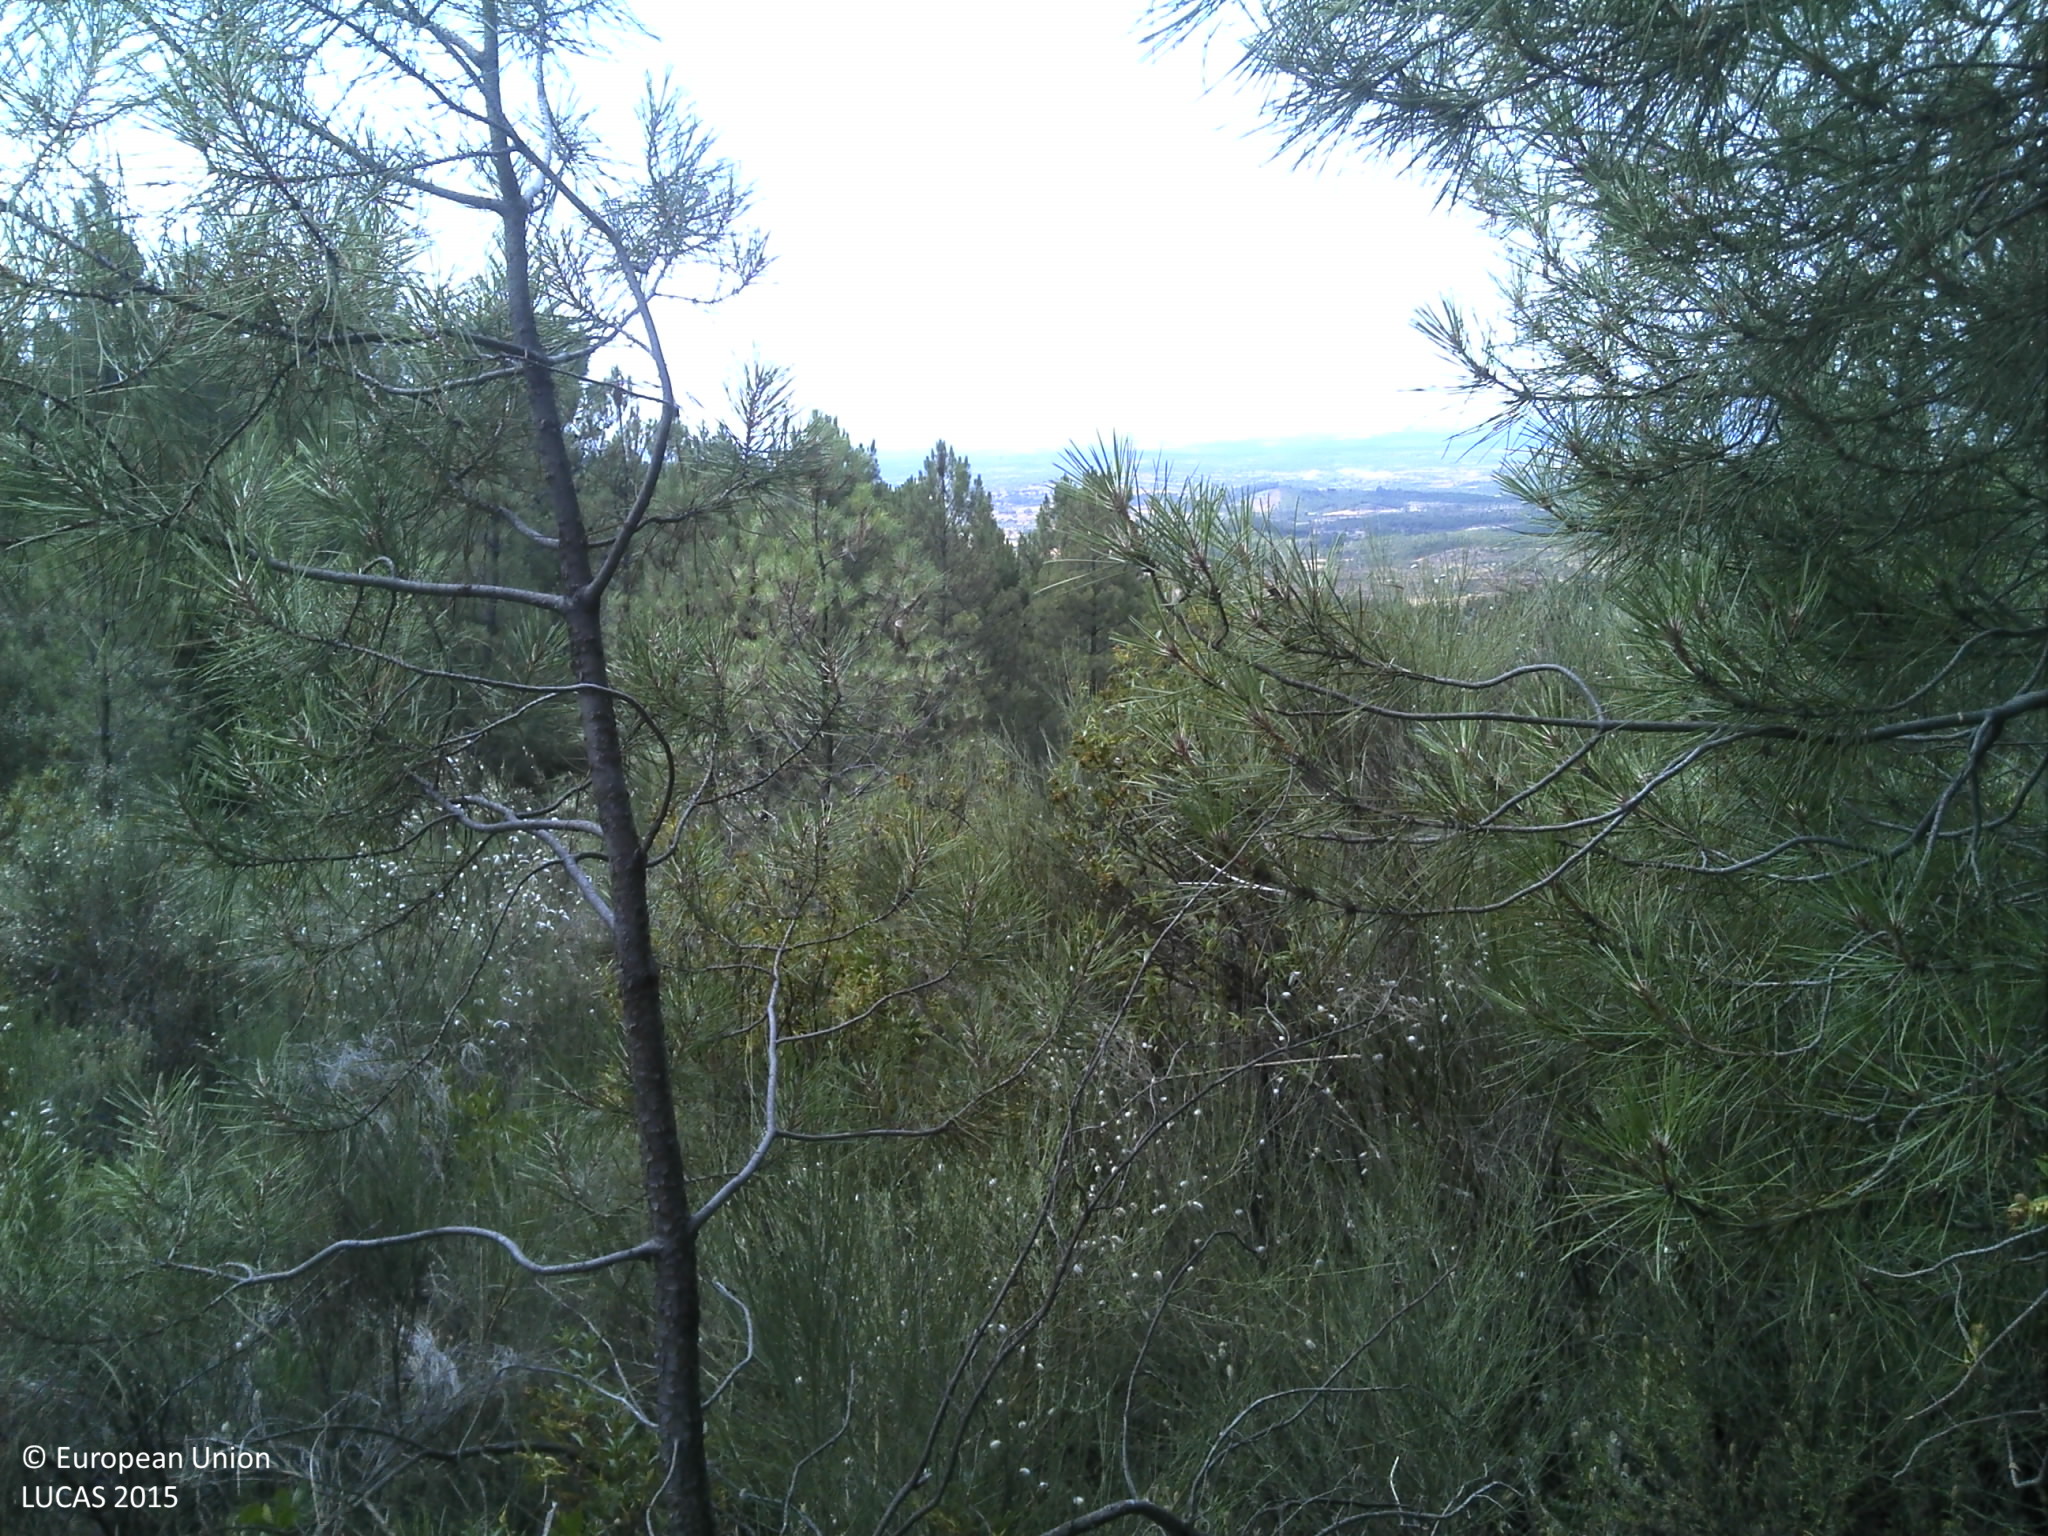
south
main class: Woodland
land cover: Pine dominated coniferous woodland
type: coniferous forest of the mediterranean region
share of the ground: 25 - 50 %
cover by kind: coniferous forest trees 45 %, shrubs 35 %, unconsolidated bare surface 20 %
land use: Forestry
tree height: > 5 m
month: June
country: PT
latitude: 40.1986
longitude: -7.1666
